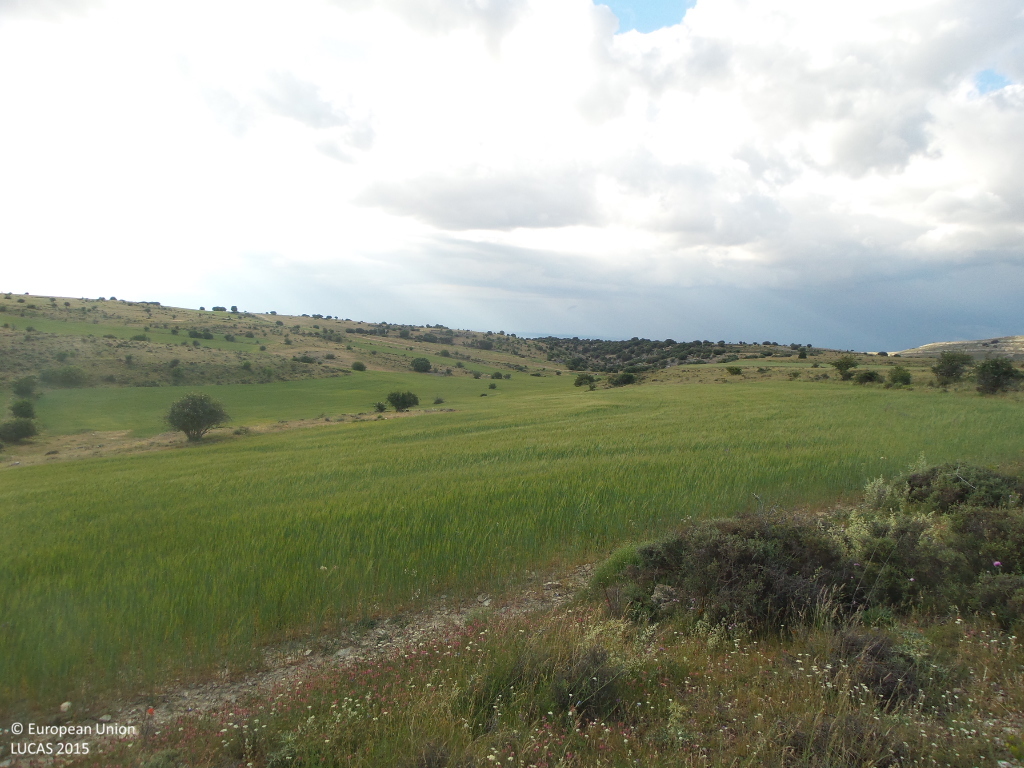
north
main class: Shrubland
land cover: Shrubland without tree cover
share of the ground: 25 - 50 %
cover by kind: shrubs 40 %, herbaceous plants 40 %, unconsolidated bare surface 20 %
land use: Semi-natural and natural areas not in use
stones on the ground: 10 - 25 %
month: June
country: ES
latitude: 41.3721
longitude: -3.0124
